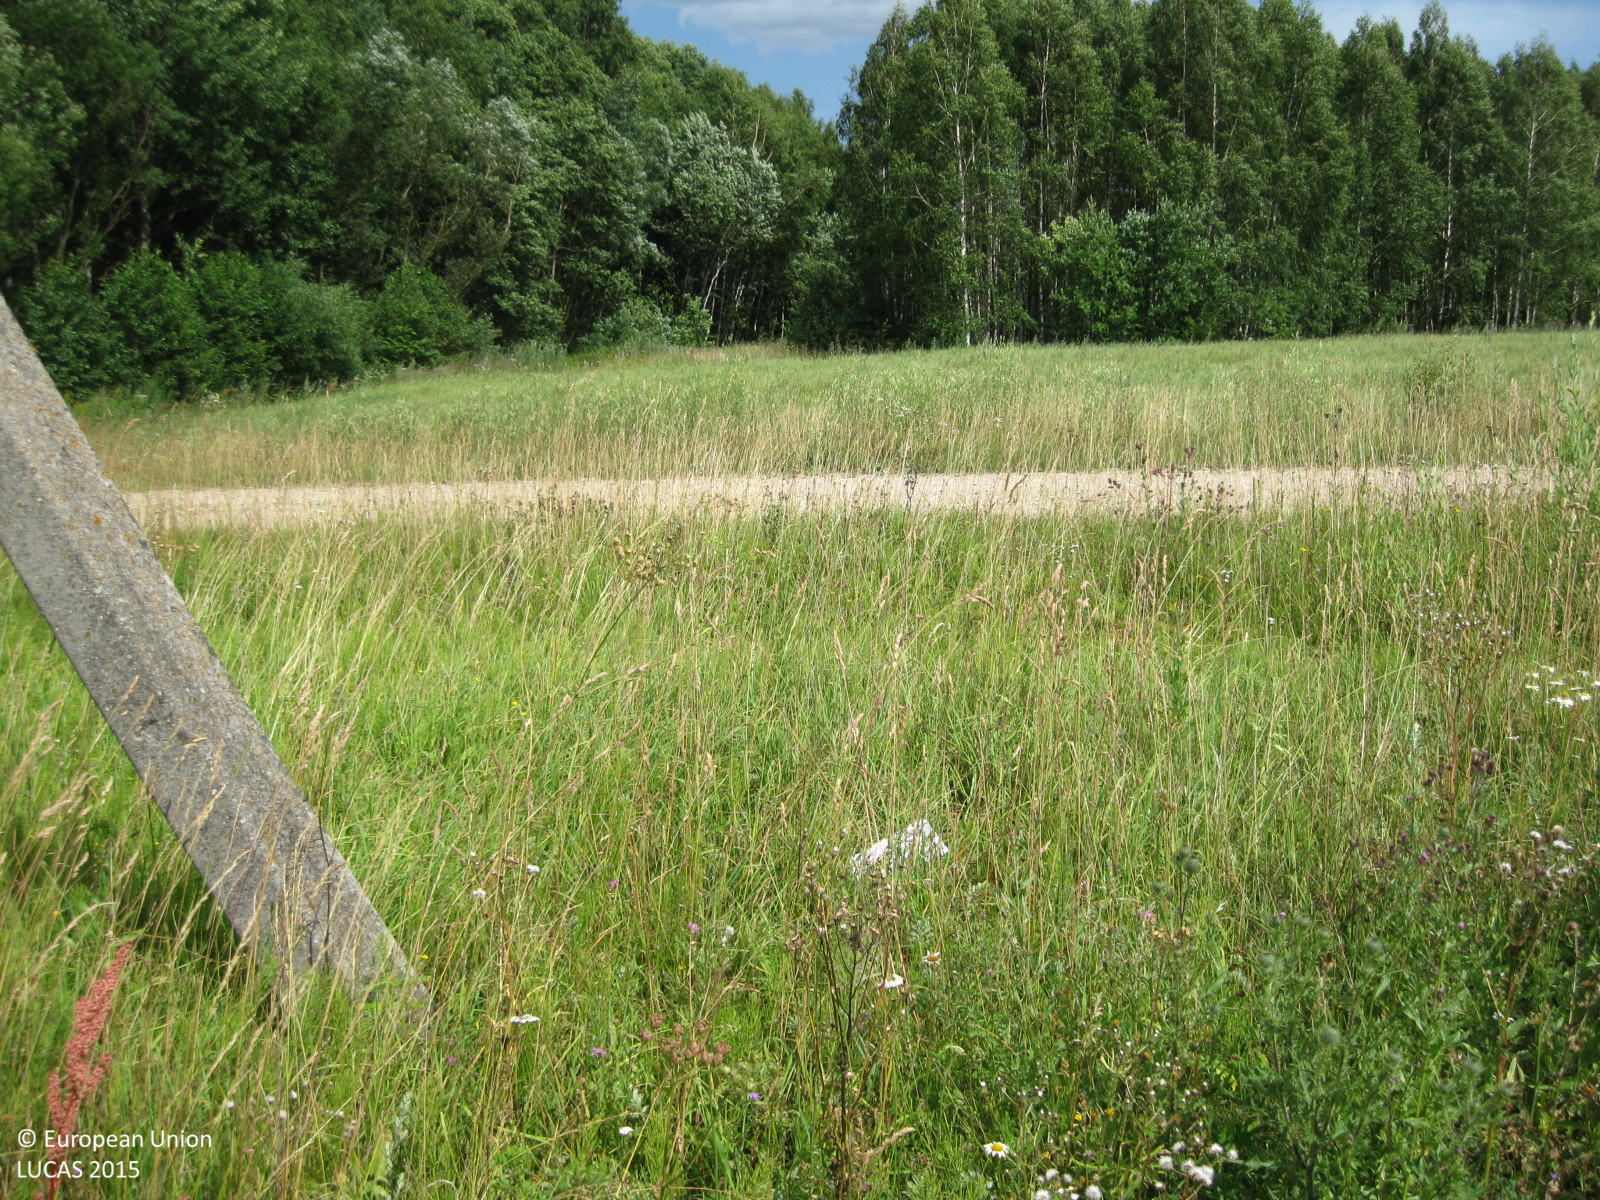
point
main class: Grassland
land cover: Grassland without tree/shrub cover
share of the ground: > 75 %
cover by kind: herbaceous plants 100 %
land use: Agriculture (excluding fallow land and kitchen gardens)
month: July
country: LT
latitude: 55.0517
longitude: 24.6146
